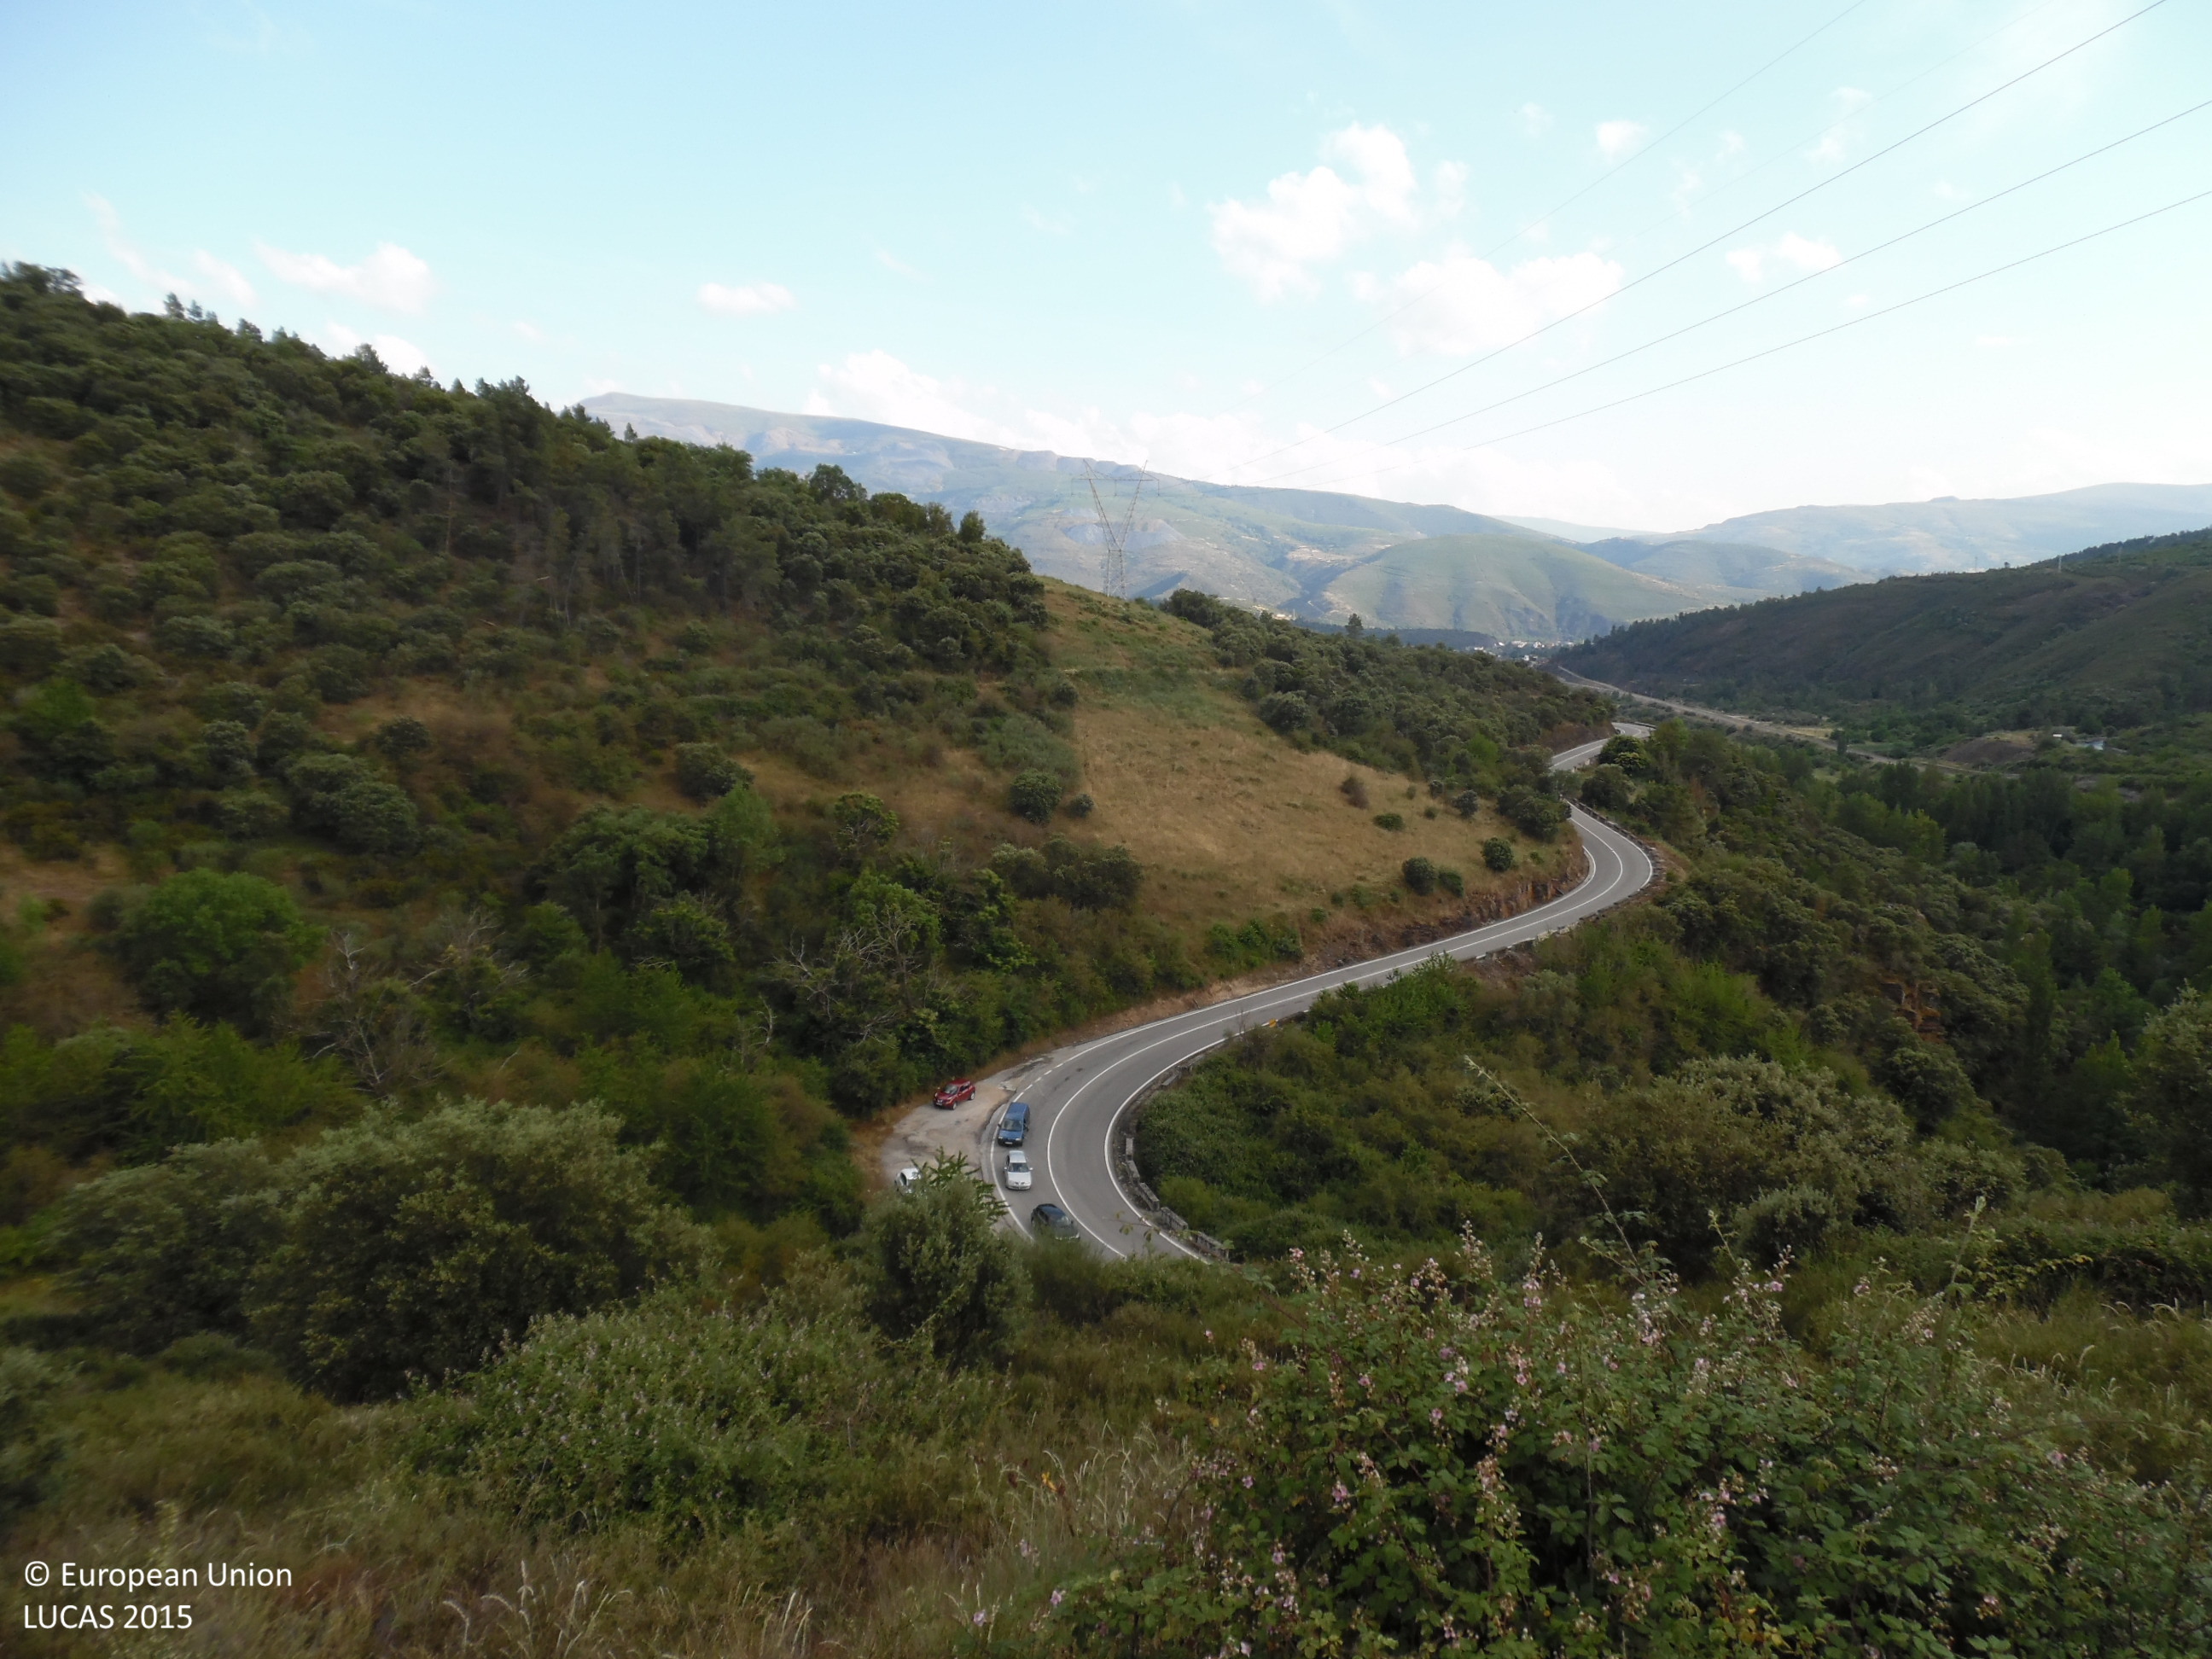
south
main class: Shrubland
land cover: Shrubland with sparse tree cover
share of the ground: > 75 %
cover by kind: shrubs 95 %, broadleaved forest trees 5 %
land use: Abandoned areas
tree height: < 5 m
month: June
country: ES
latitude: 42.4507
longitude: -6.8180
